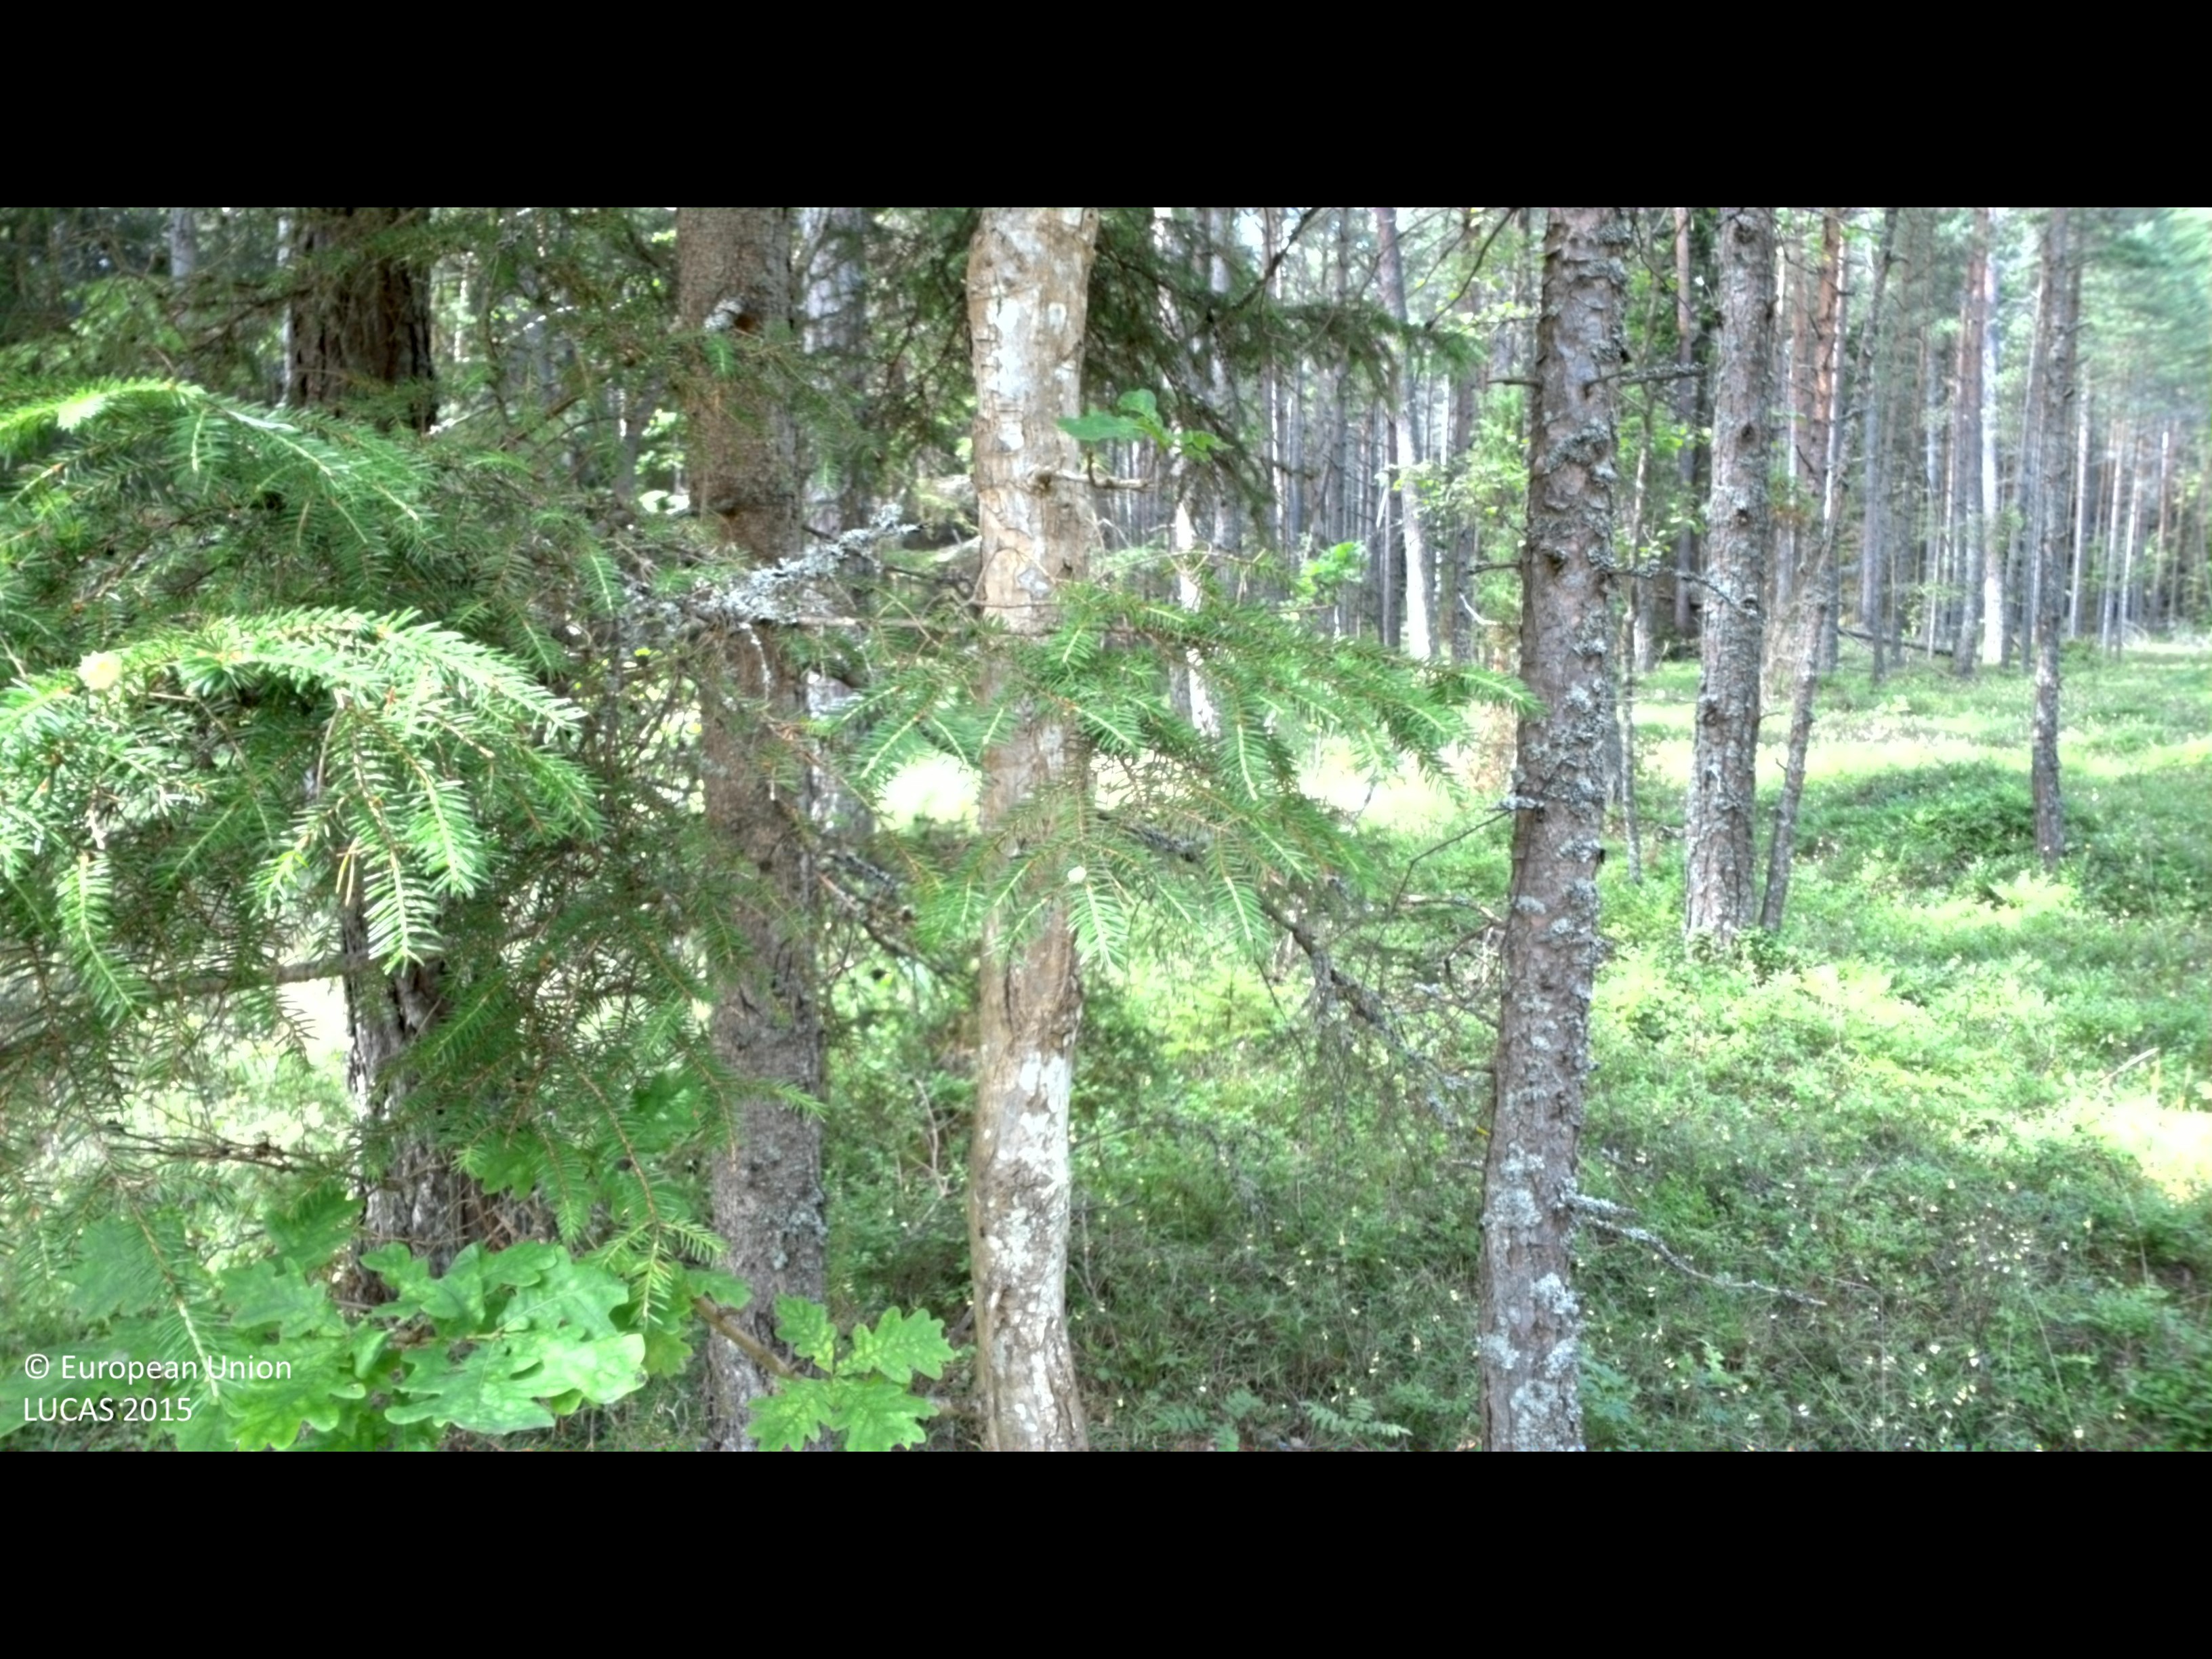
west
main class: Woodland
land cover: Pine dominated coniferous woodland
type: boreal forest
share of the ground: 50 - 75 %
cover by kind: coniferous forest trees 65 %, shrubs 20 %, herbaceous plants 10 %, lichens and mosses 5 %
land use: Forestry
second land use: Amenities, museums, leisure
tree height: > 5 m
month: July
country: SE
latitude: 57.3259
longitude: 17.1269
